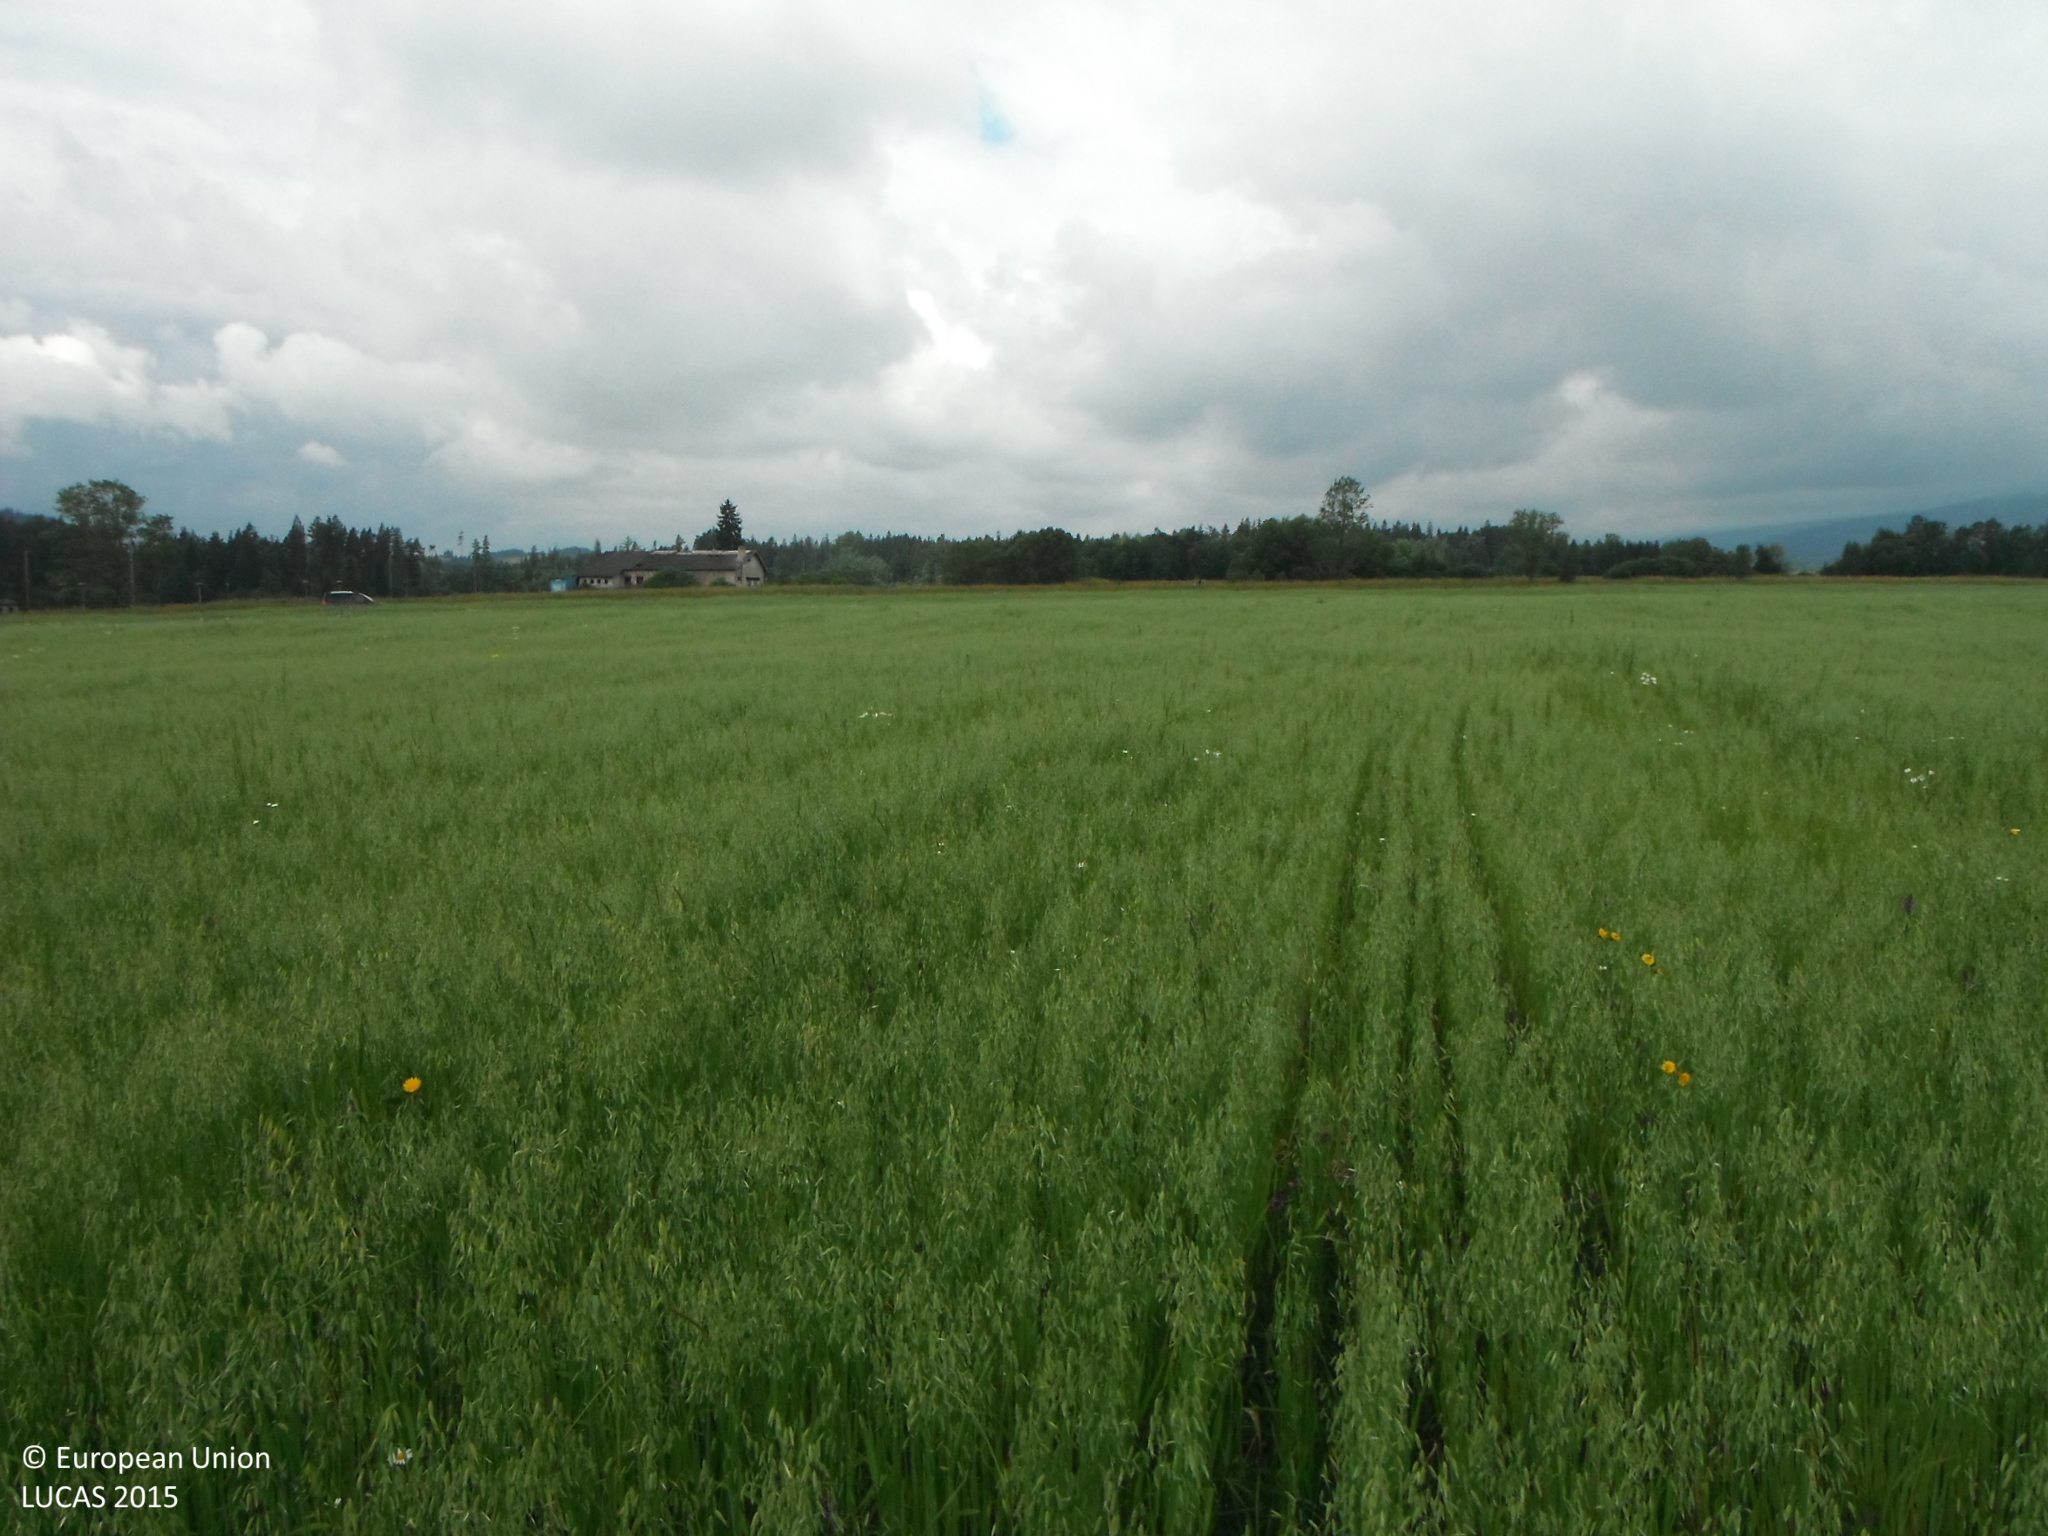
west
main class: Cropland
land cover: Oats
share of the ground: > 75 %
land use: Agriculture (excluding fallow land and kitchen gardens)
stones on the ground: > 50 %
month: July
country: SK
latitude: 49.0598
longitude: 20.1457
